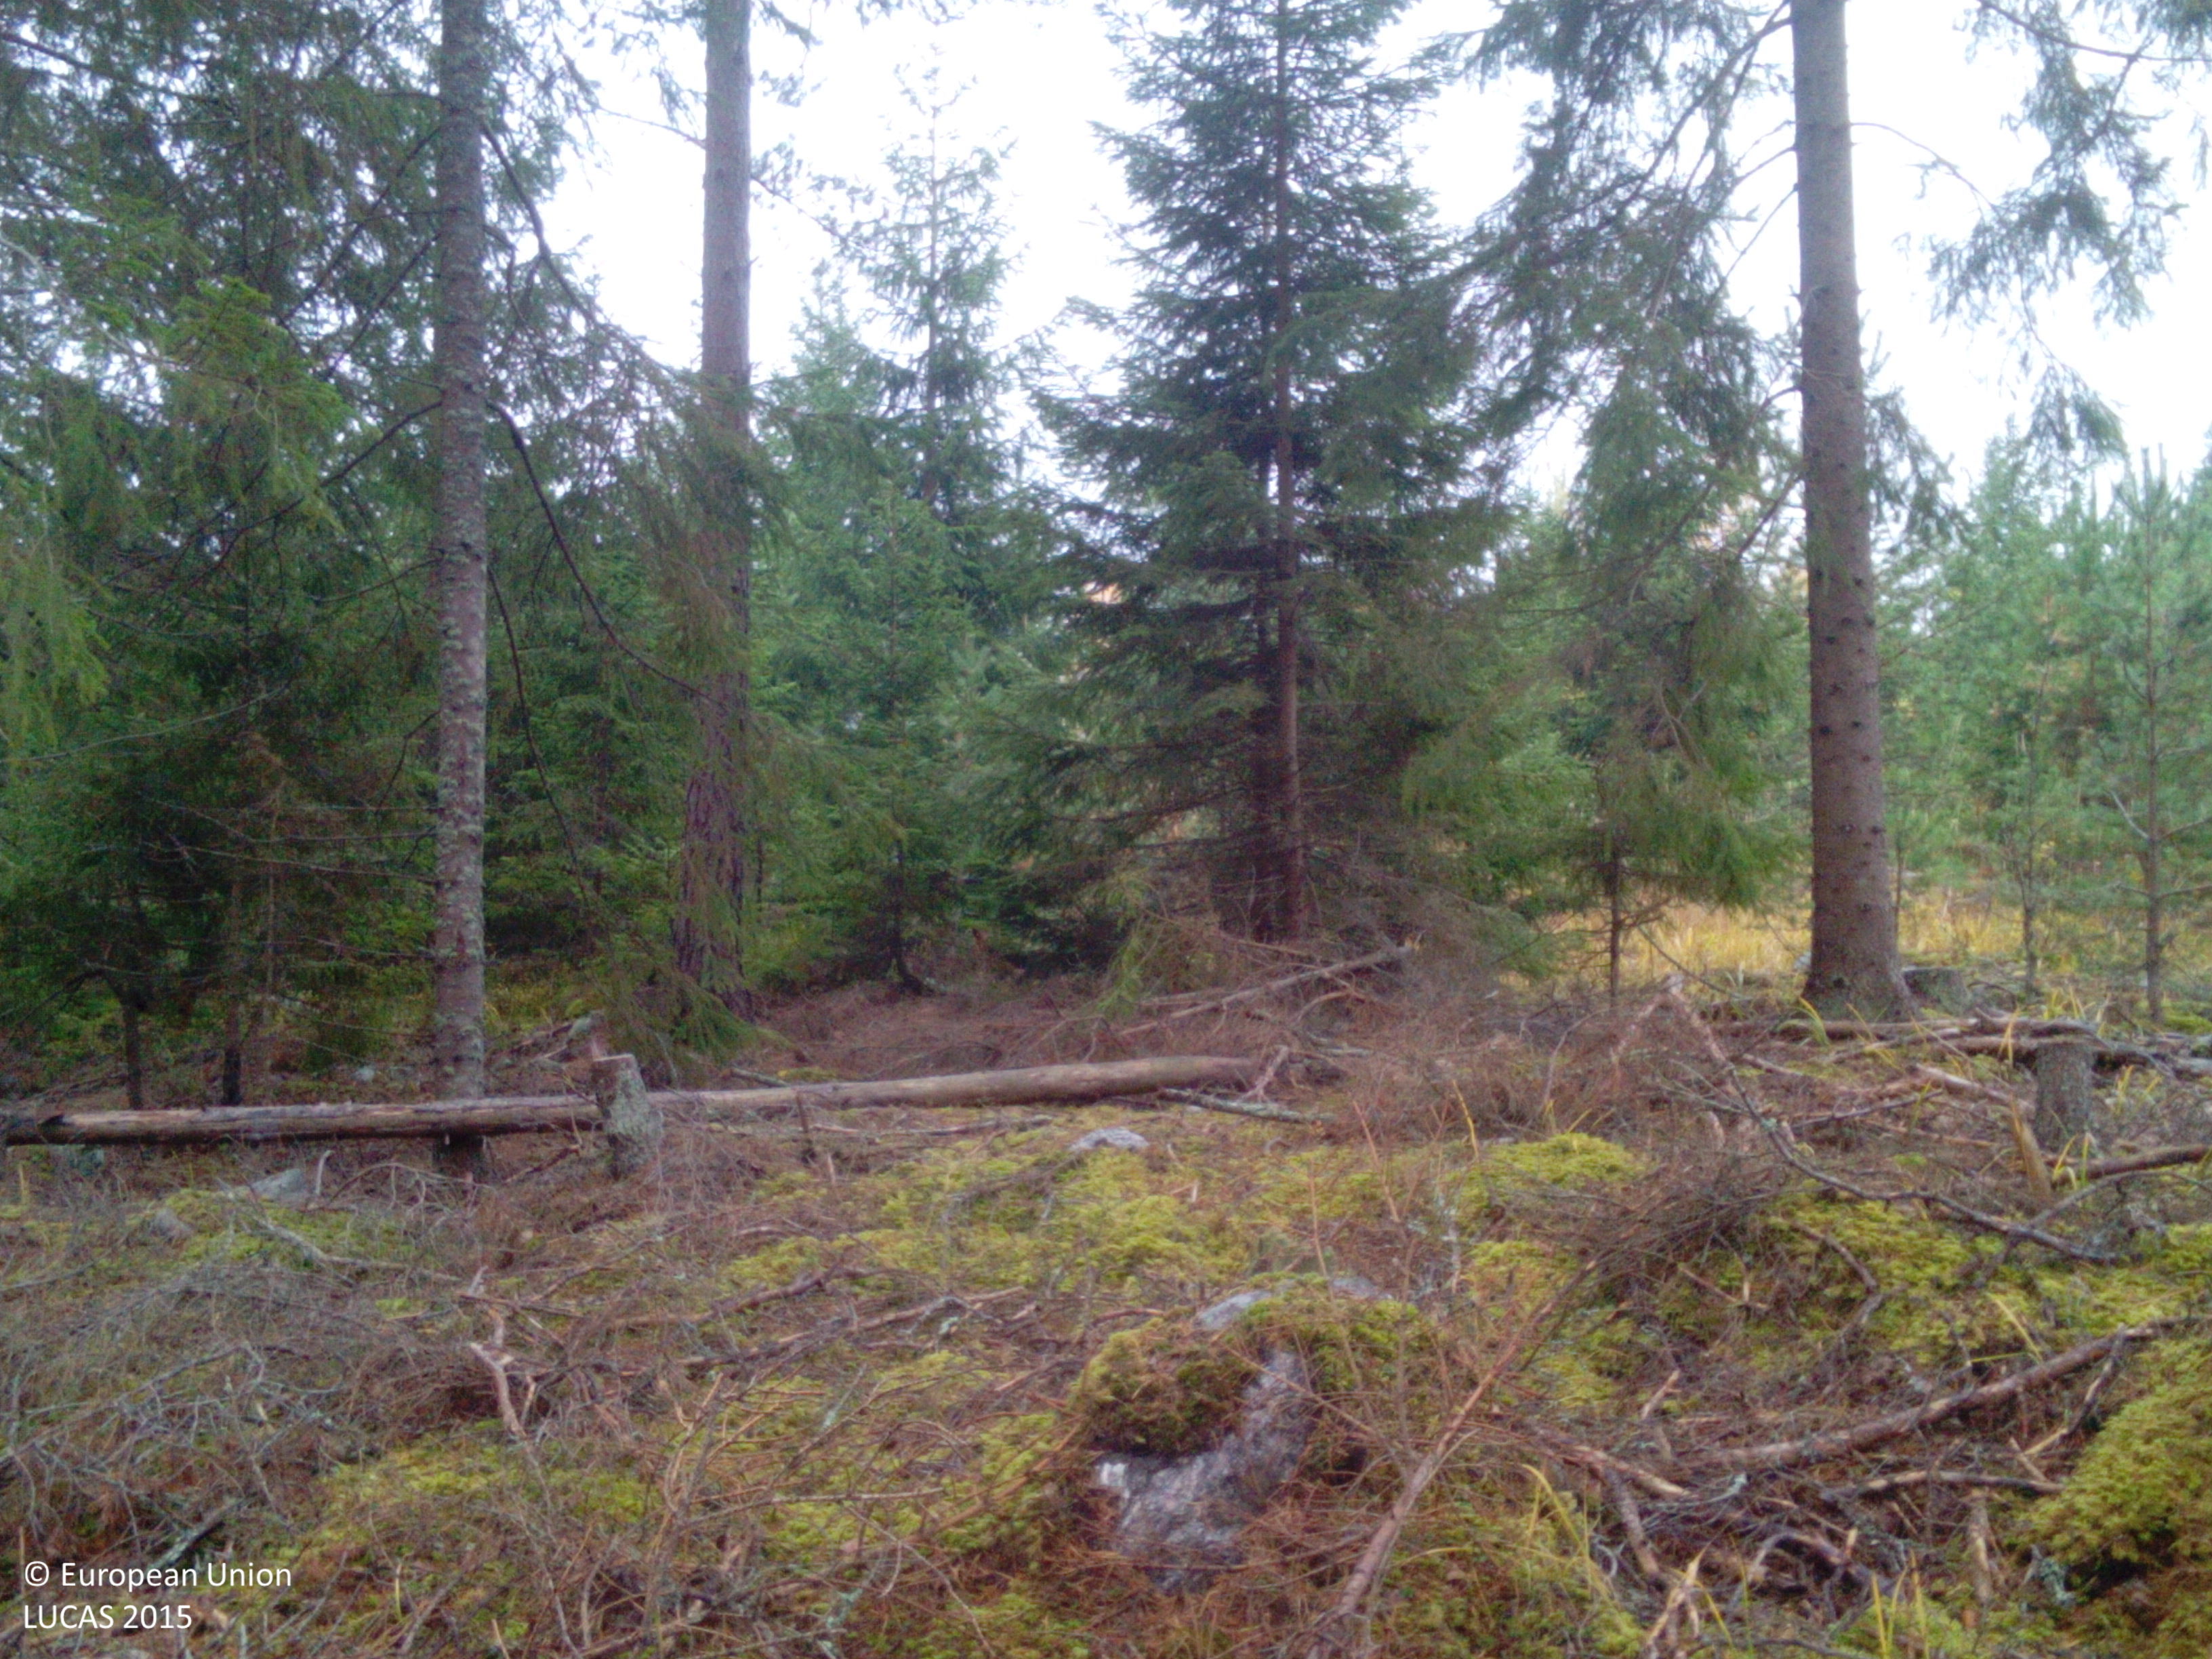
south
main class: Woodland
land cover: Other coniferous woodland
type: boreal forest
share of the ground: > 75 %
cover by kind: coniferous forest trees 85 %, lichens and mosses 10 %, herbaceous plants 5 %
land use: Forestry
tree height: > 5 m
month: October
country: SE
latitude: 59.1415
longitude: 16.1984
